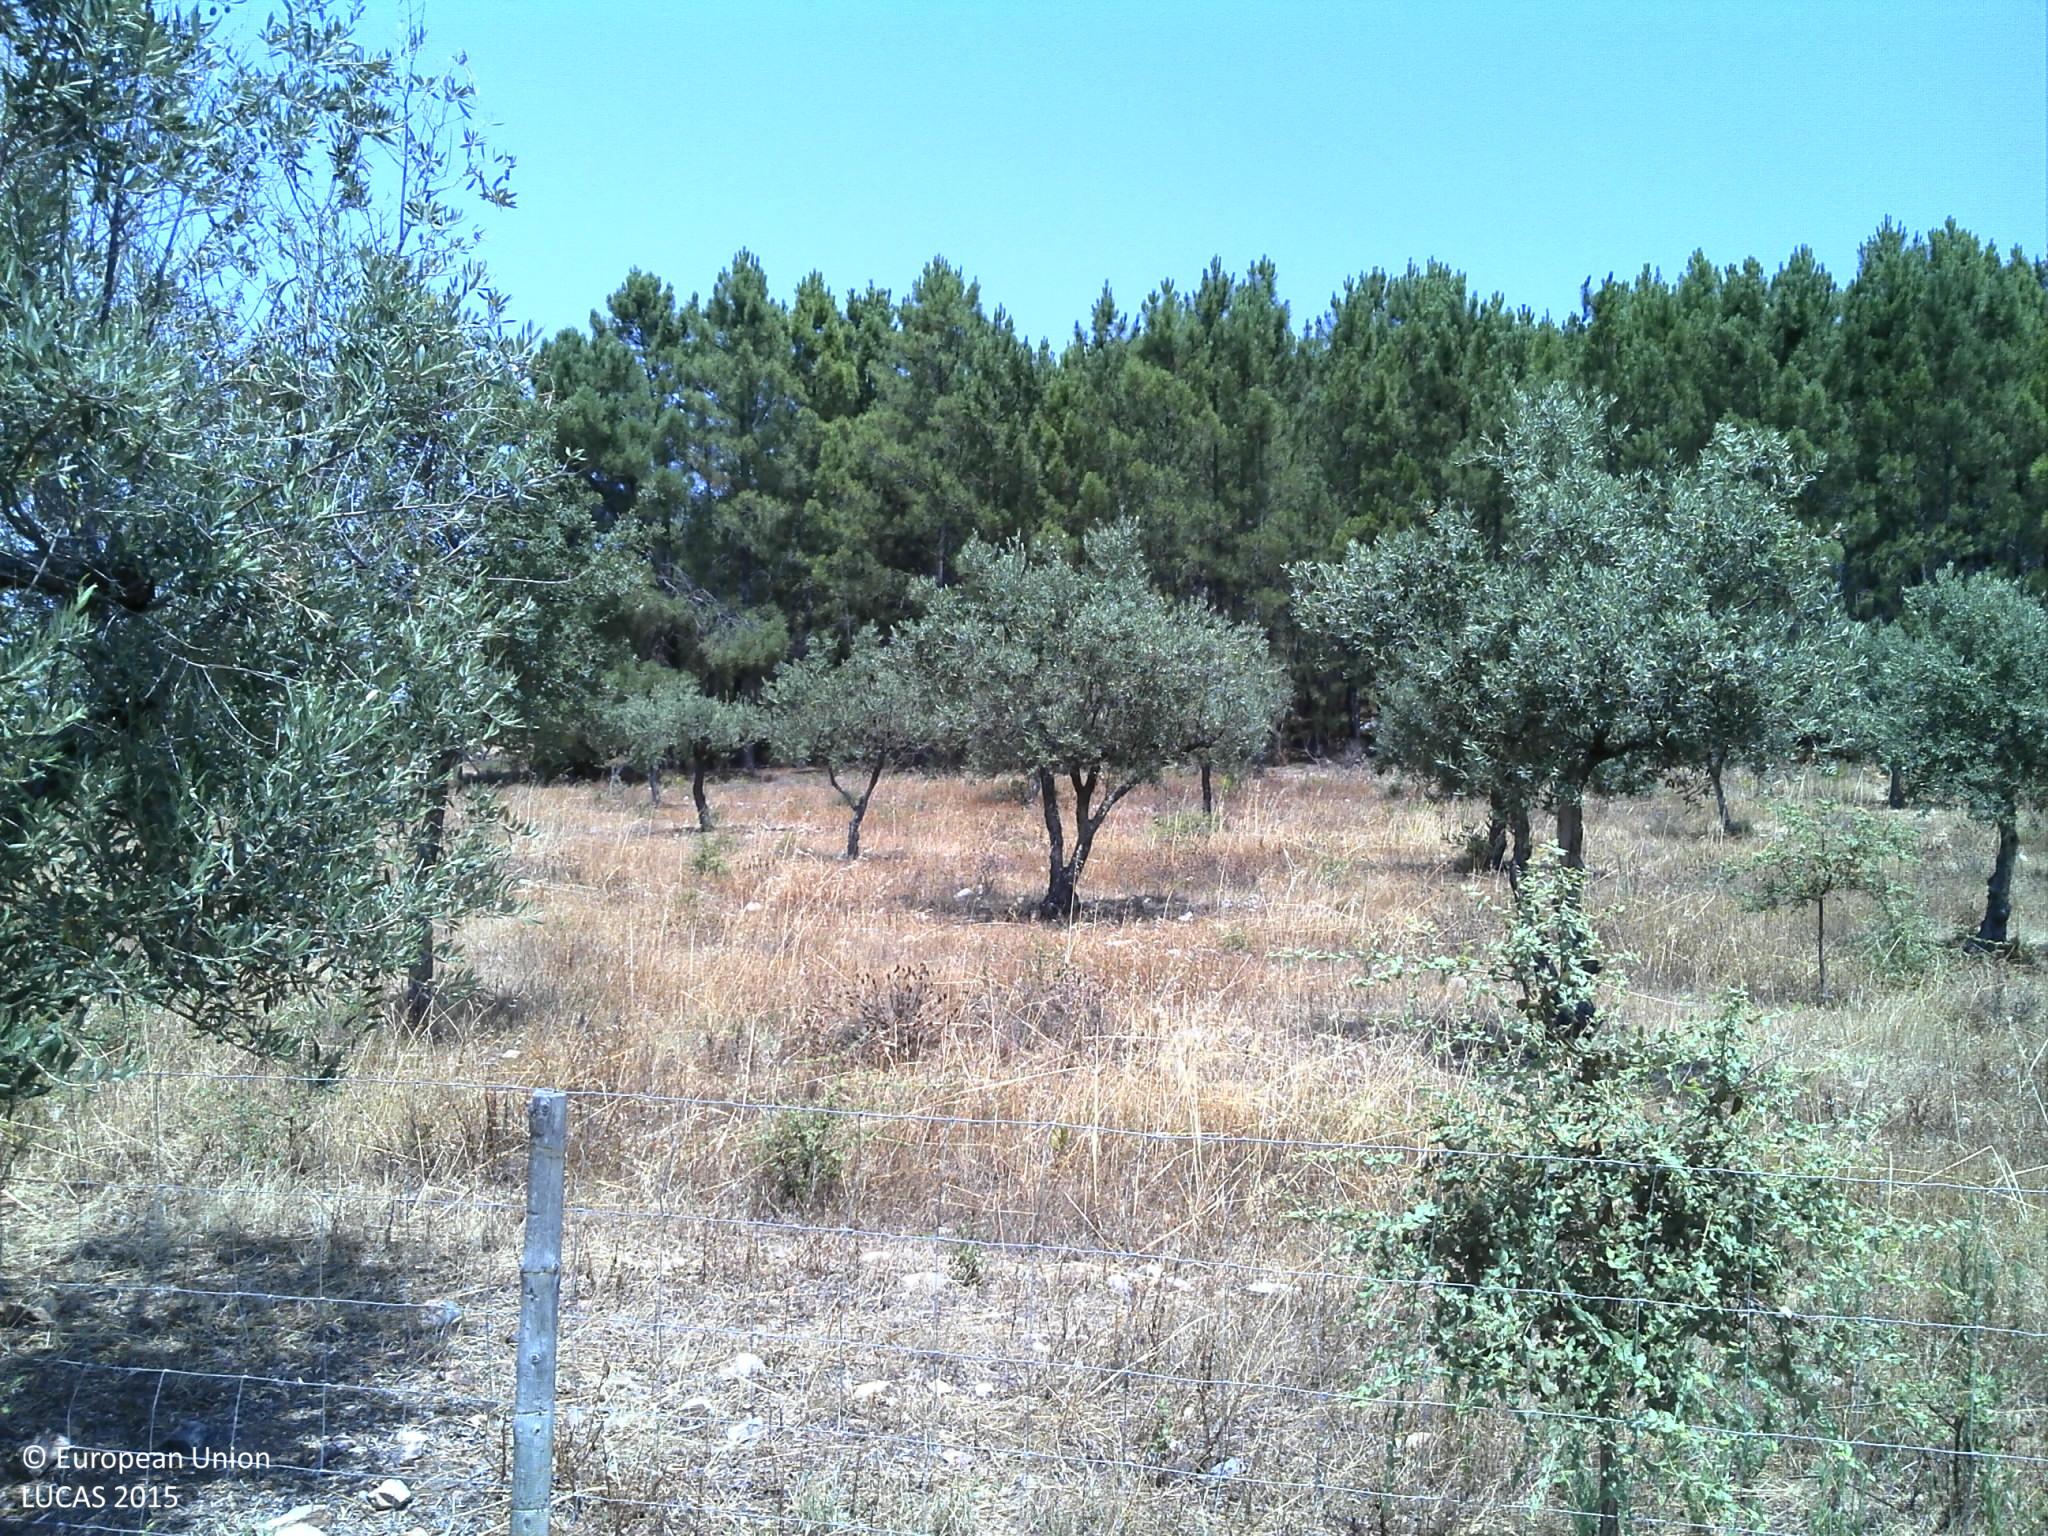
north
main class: Cropland
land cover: Olive groves
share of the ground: 10 - 25 %
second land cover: Grassland without tree/shrub cover
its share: 10 - 25 %
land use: Agriculture (excluding fallow land and kitchen gardens)
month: August
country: PT
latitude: 39.2767
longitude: -7.3697
